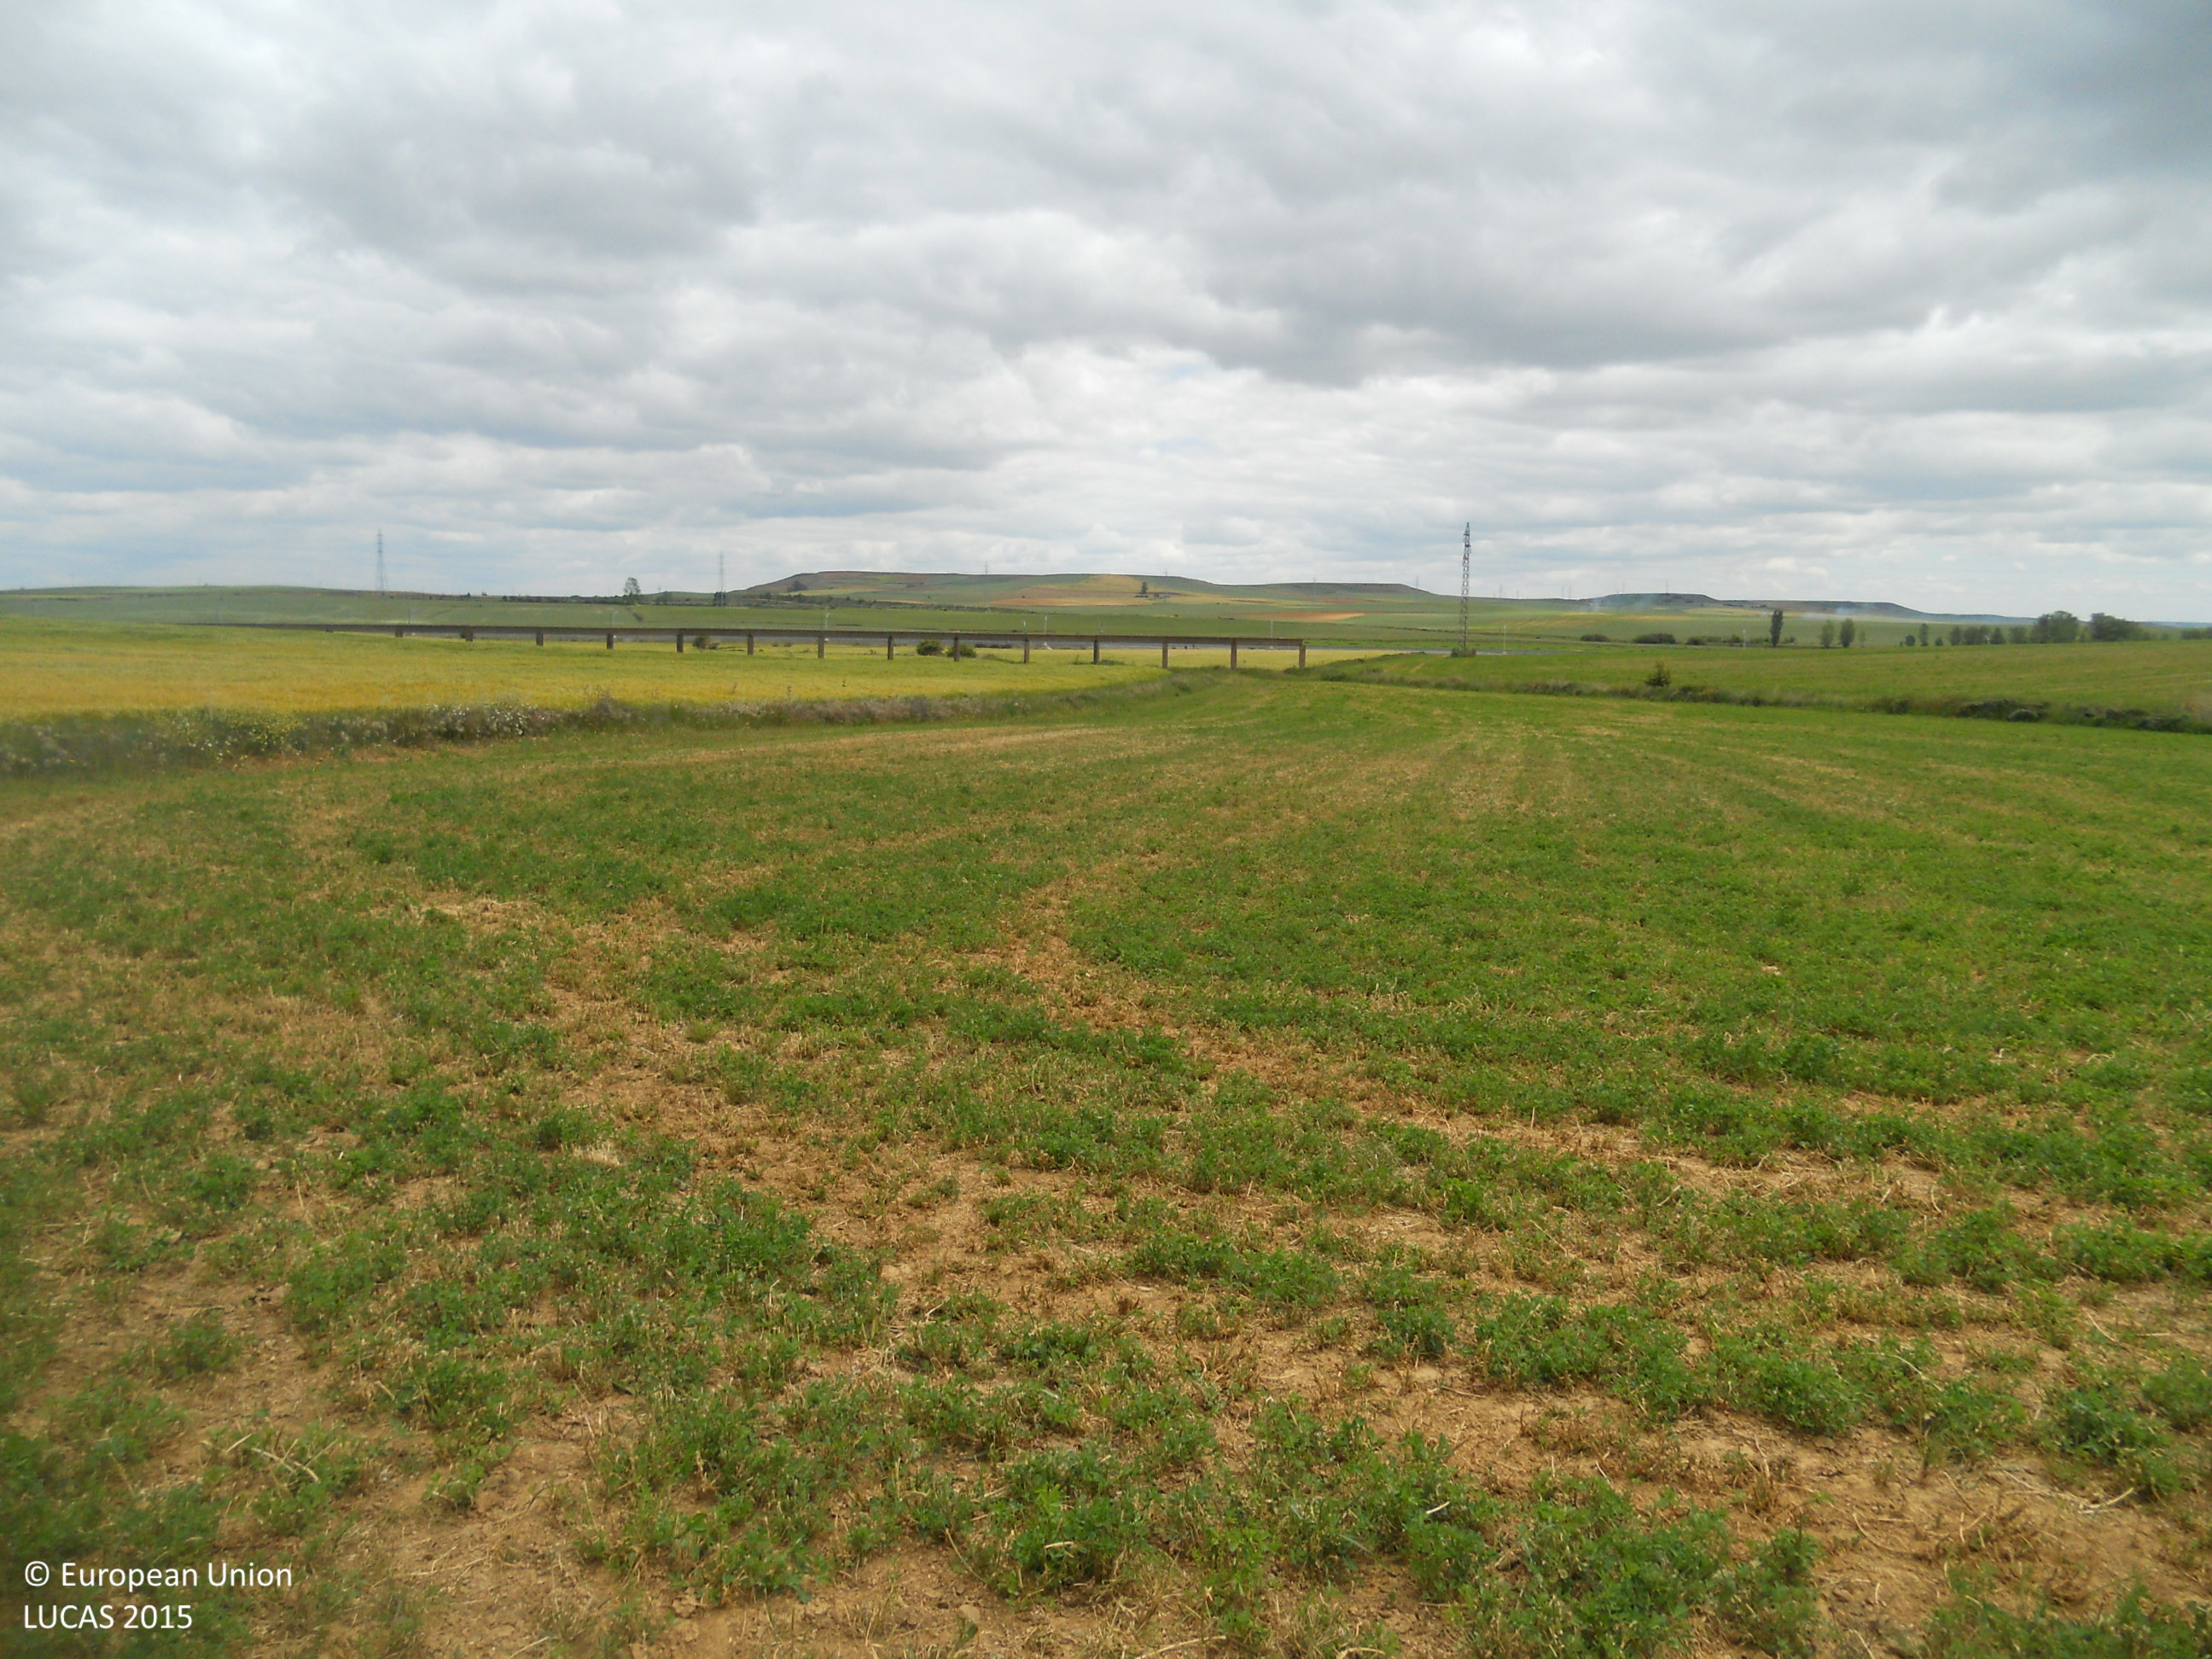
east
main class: Cropland
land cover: Lucerne
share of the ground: > 75 %
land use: Agriculture (excluding fallow land and kitchen gardens)
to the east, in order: Lucerne; Electric lines; Lucerne; Grass margins; Barley; Grass margins; Ditches and canals; Grassland without tree/shrub cover; Rivers and streams; Grass margins; Barley
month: May
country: ES
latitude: 42.3925
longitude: -4.3698
